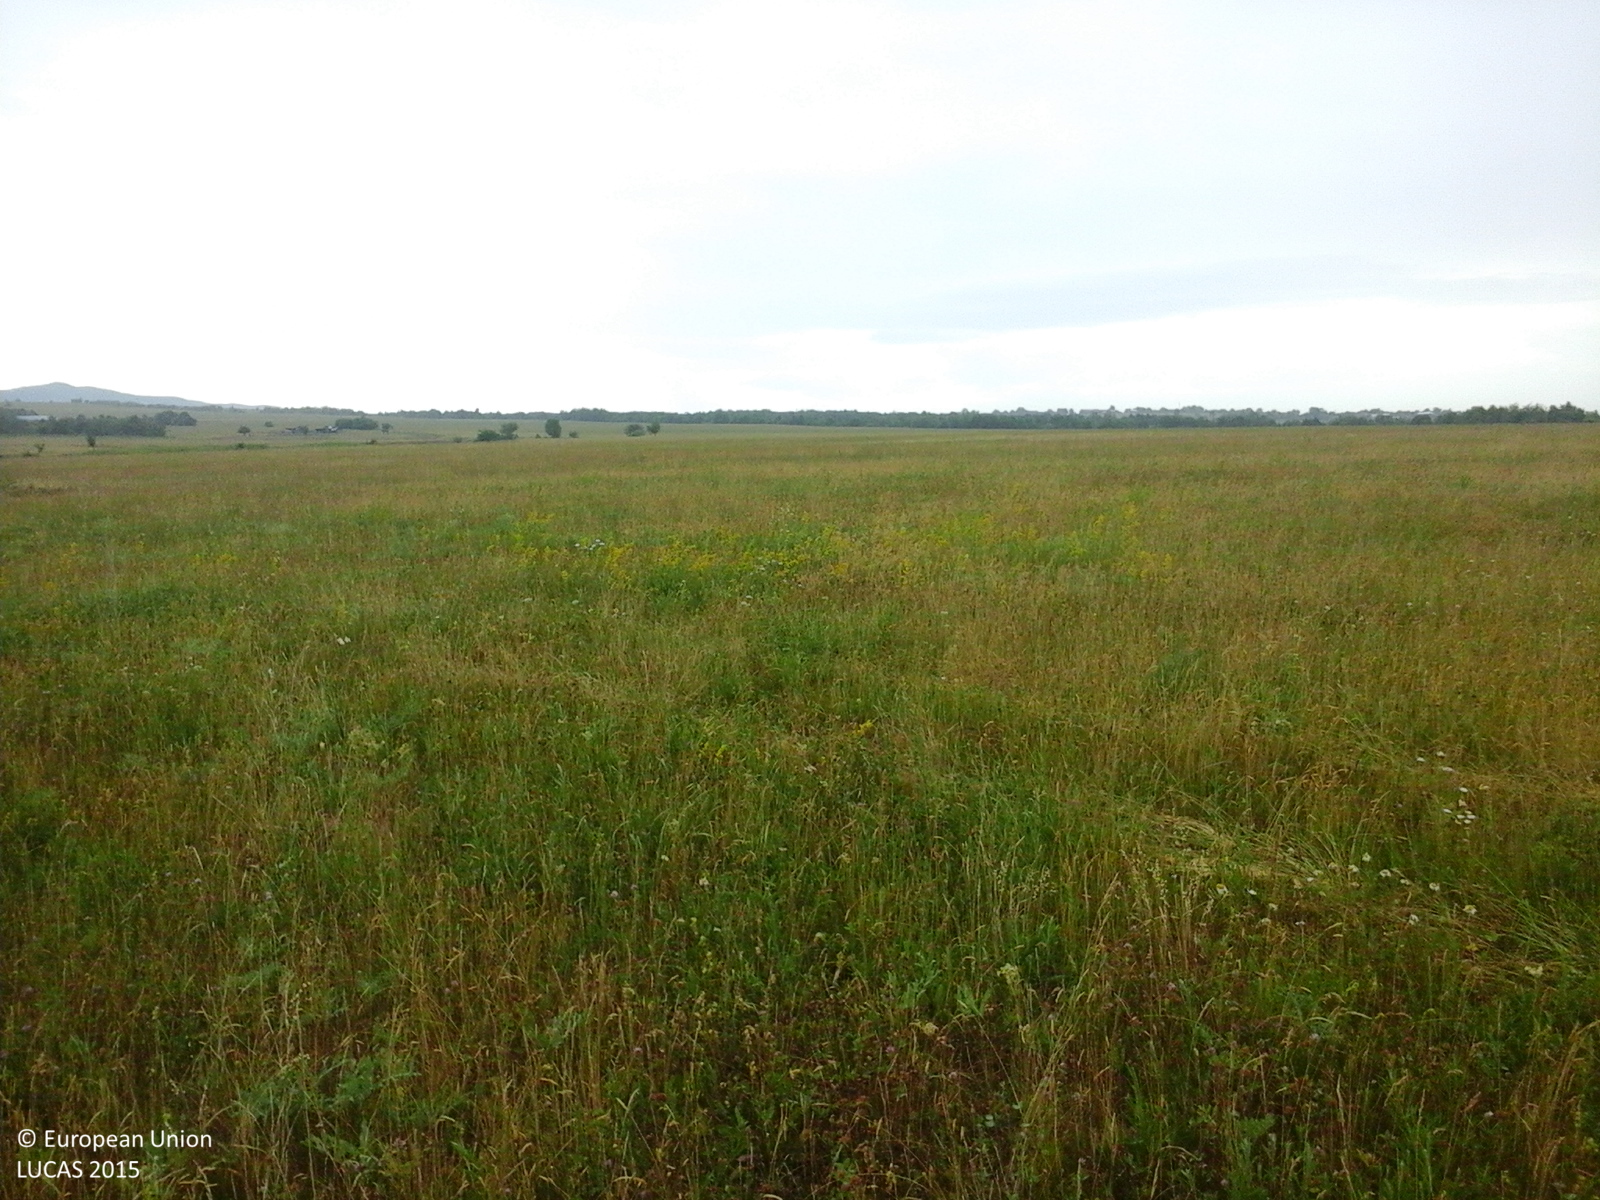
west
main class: Grassland
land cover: Spontaneously vegetated surfaces
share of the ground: 50 - 75 %
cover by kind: herbaceous plants 100 %
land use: Agriculture (excluding fallow land and kitchen gardens)
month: June
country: RO
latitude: 47.3231
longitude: 26.3443
